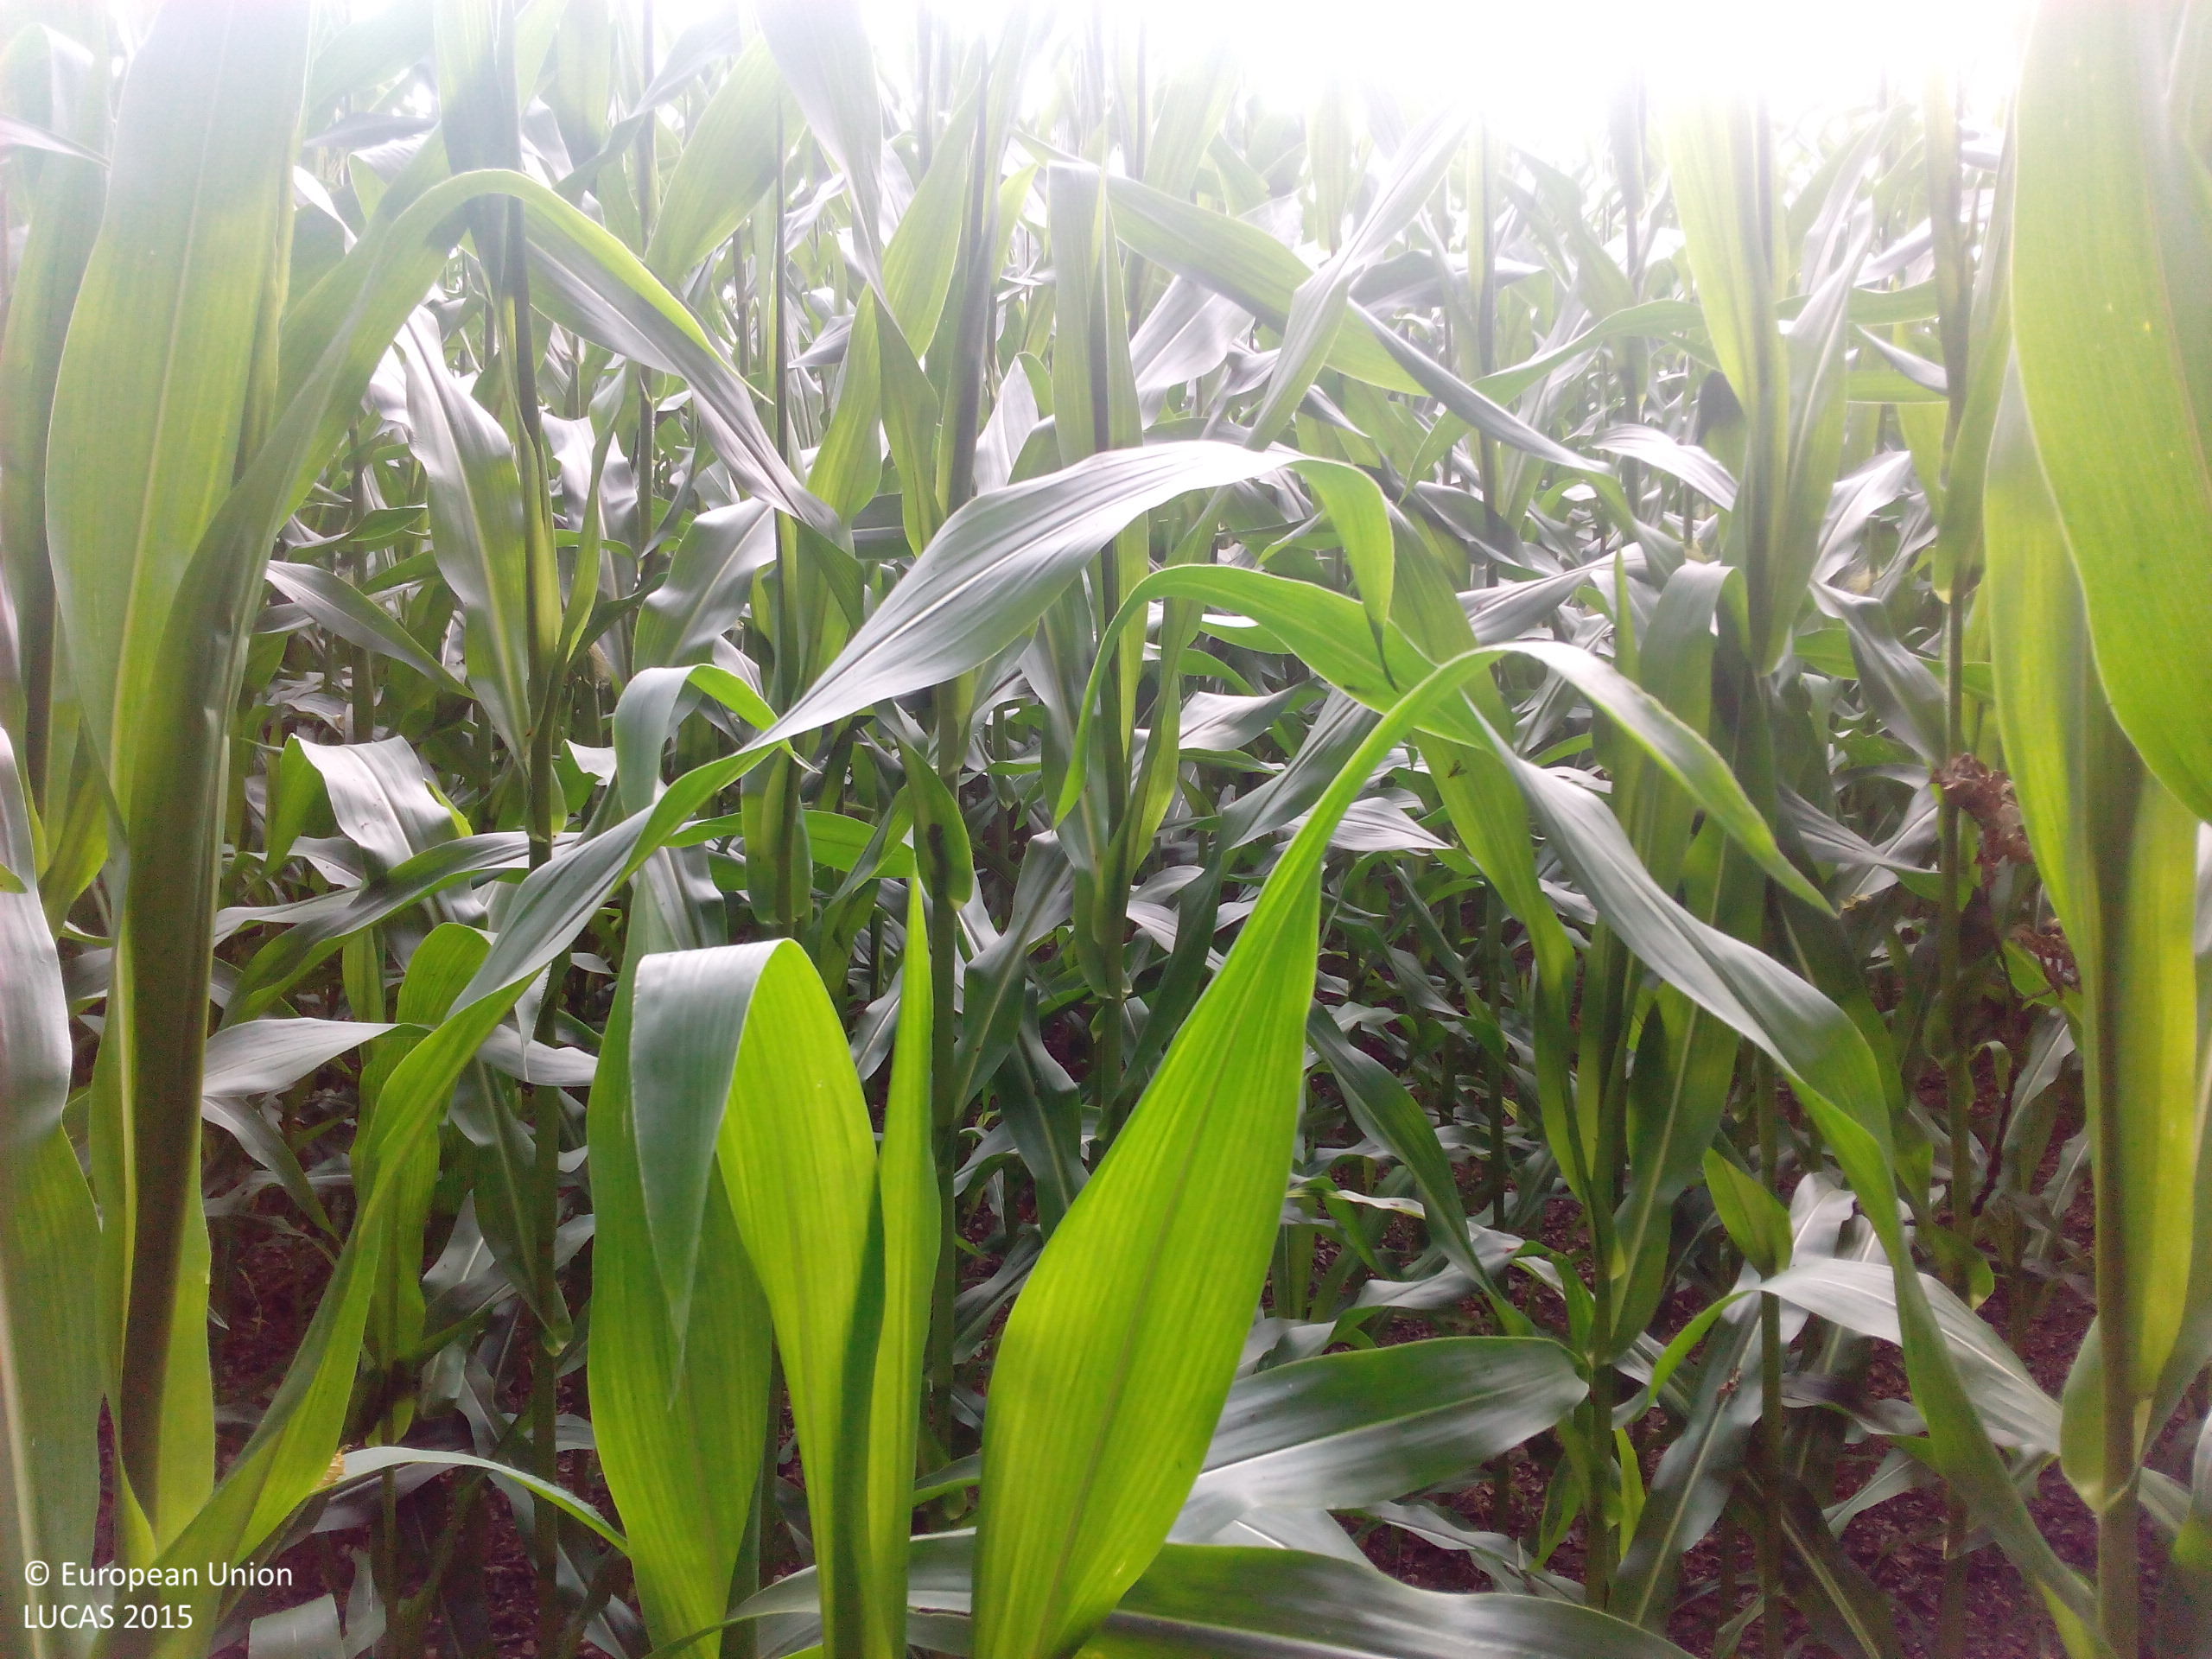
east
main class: Cropland
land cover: Maize
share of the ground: > 75 %
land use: Agriculture (excluding fallow land and kitchen gardens)
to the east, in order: Maize; Grassland without tree/shrub cover; Artificial constructions in urban areas
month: July
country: DE
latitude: 48.3115
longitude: 12.8981
